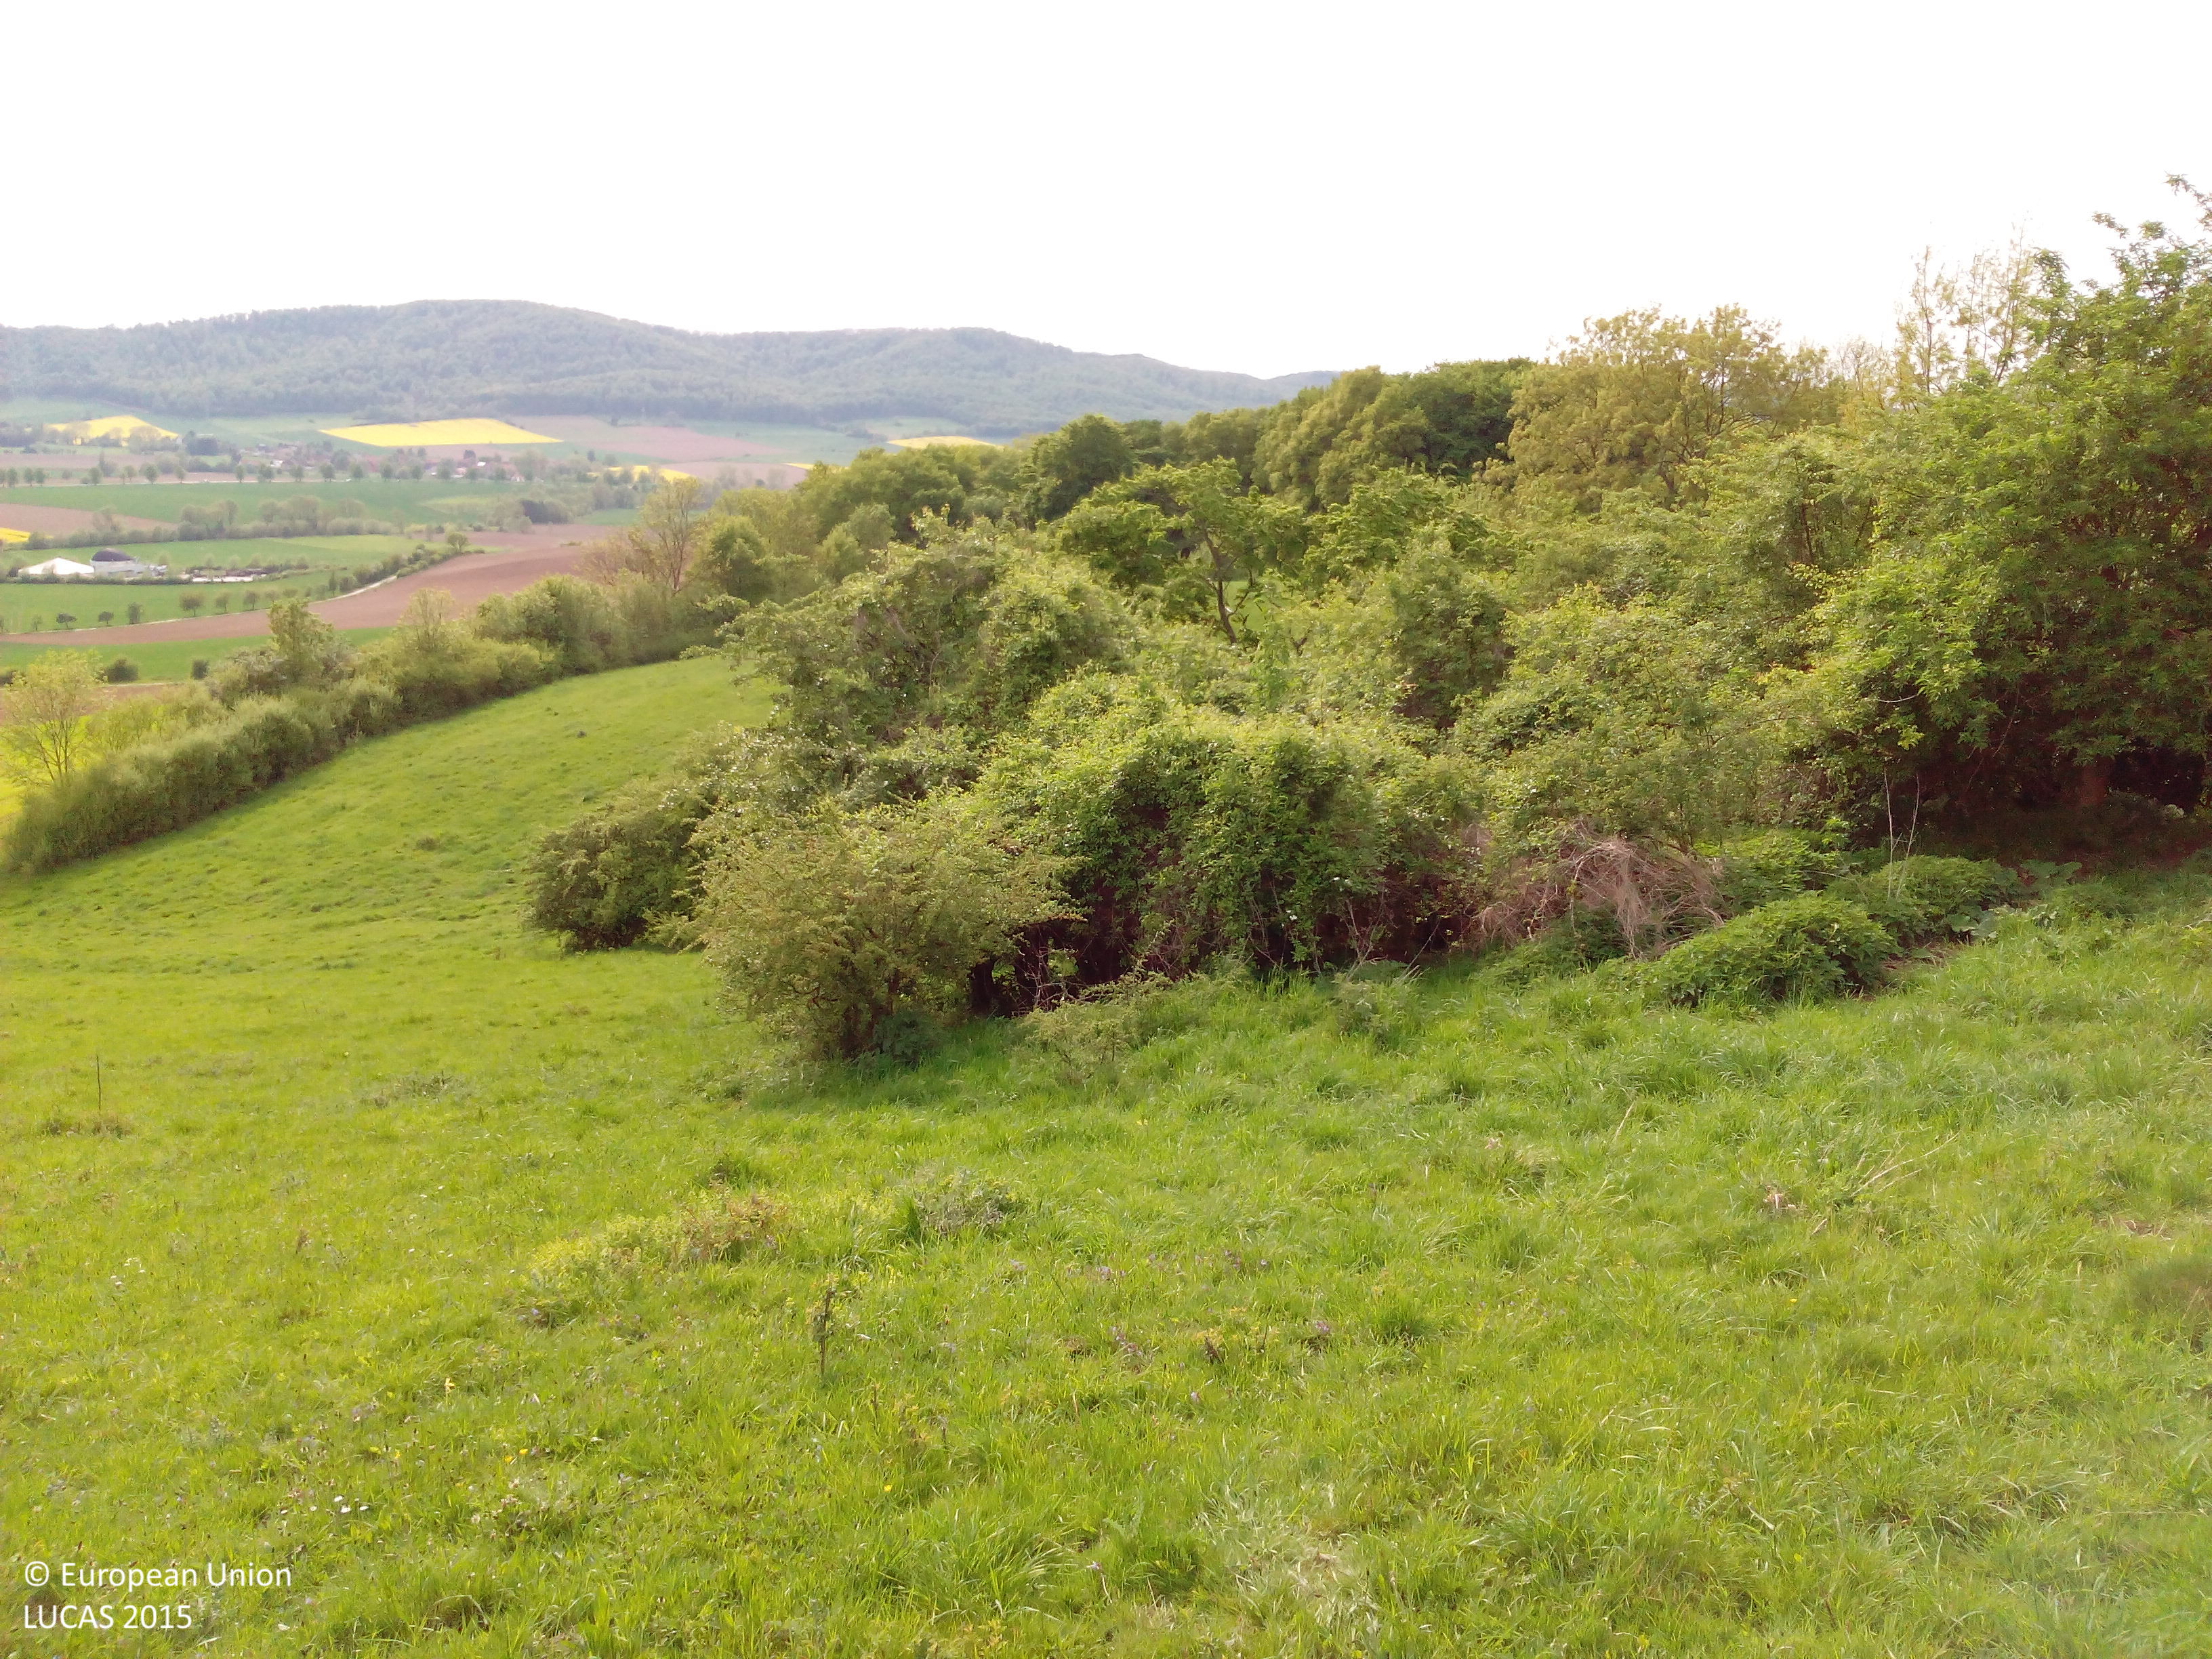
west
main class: Grassland
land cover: Grassland without tree/shrub cover
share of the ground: > 75 %
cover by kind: herbaceous plants 100 %
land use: Agriculture (excluding fallow land and kitchen gardens)
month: May
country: DE
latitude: 52.0354
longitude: 9.6357
